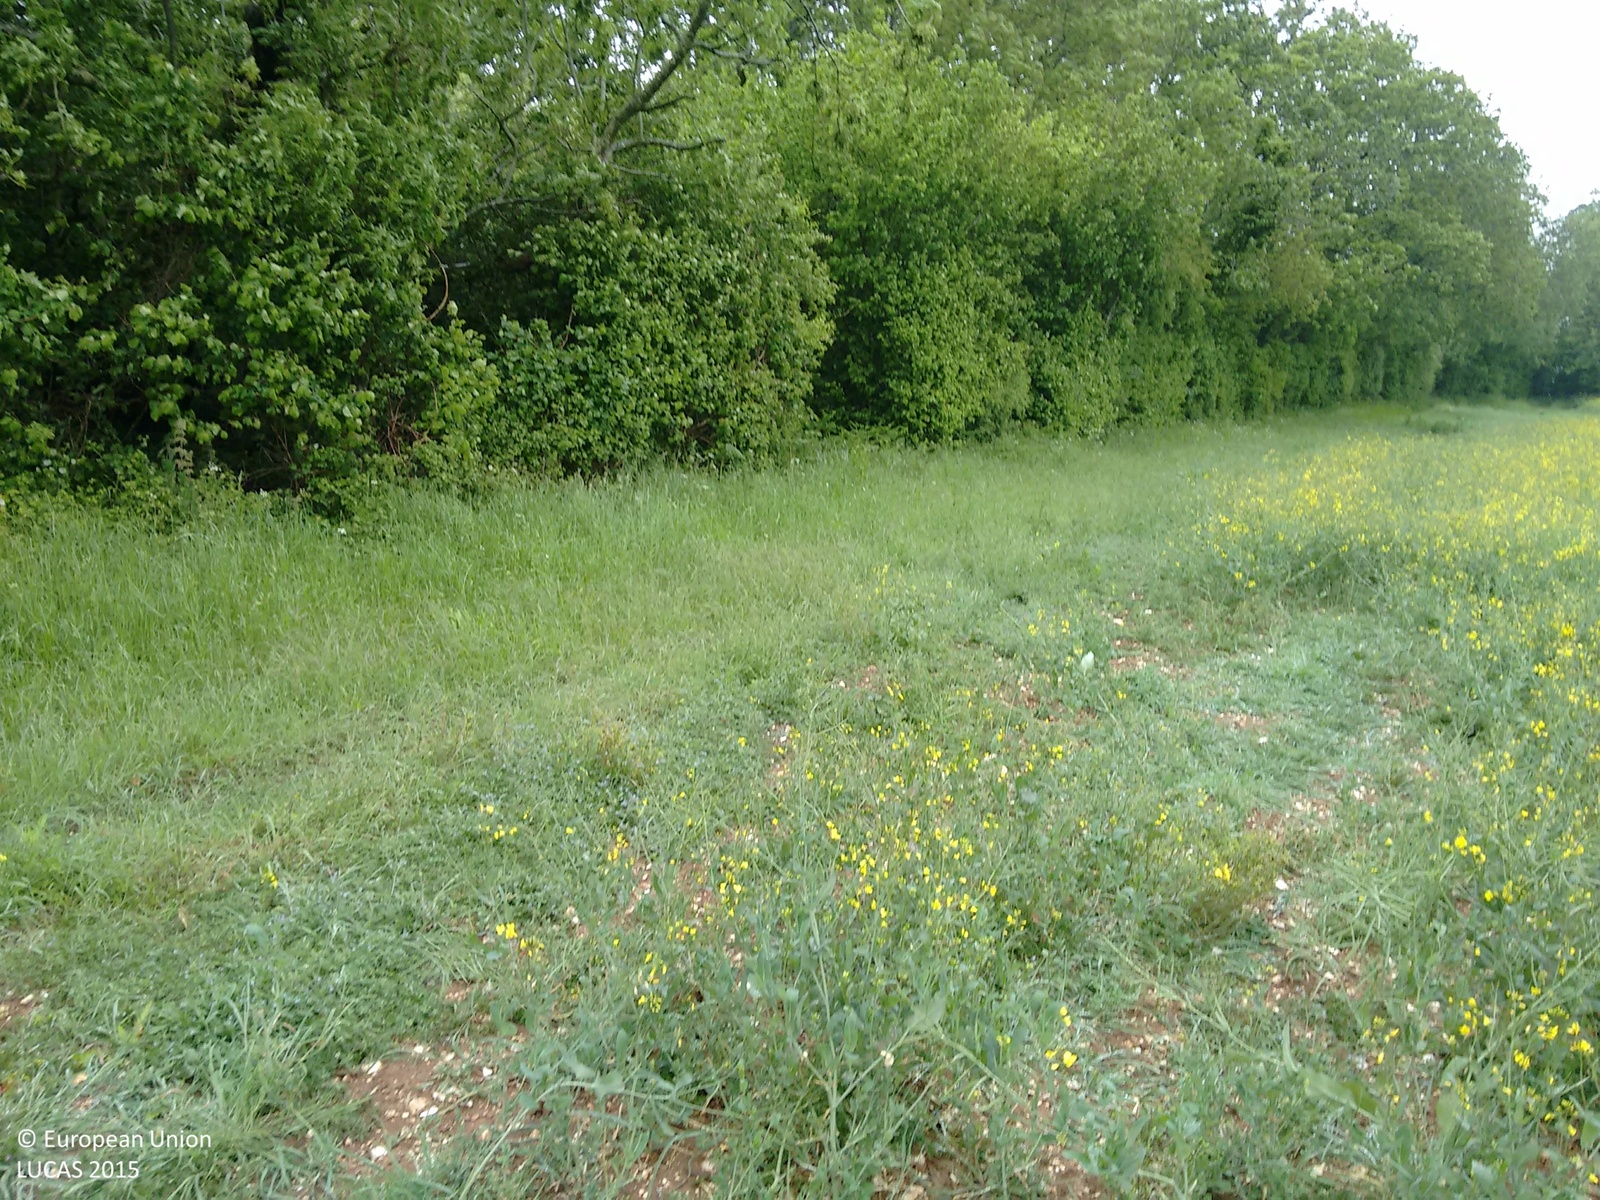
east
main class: Cropland
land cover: Rape and turnip rape
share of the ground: > 75 %
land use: Agriculture (excluding fallow land and kitchen gardens)
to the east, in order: Rape and turnip rape; Spontaneously vegetated surfaces; Broadleaved woodland; Fences; Grassland without tree/shrub cover; Artificial constructions in urban areas; Grassland without tree/shrub cover
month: June
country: GB
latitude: 51.1271
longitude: -1.1199
